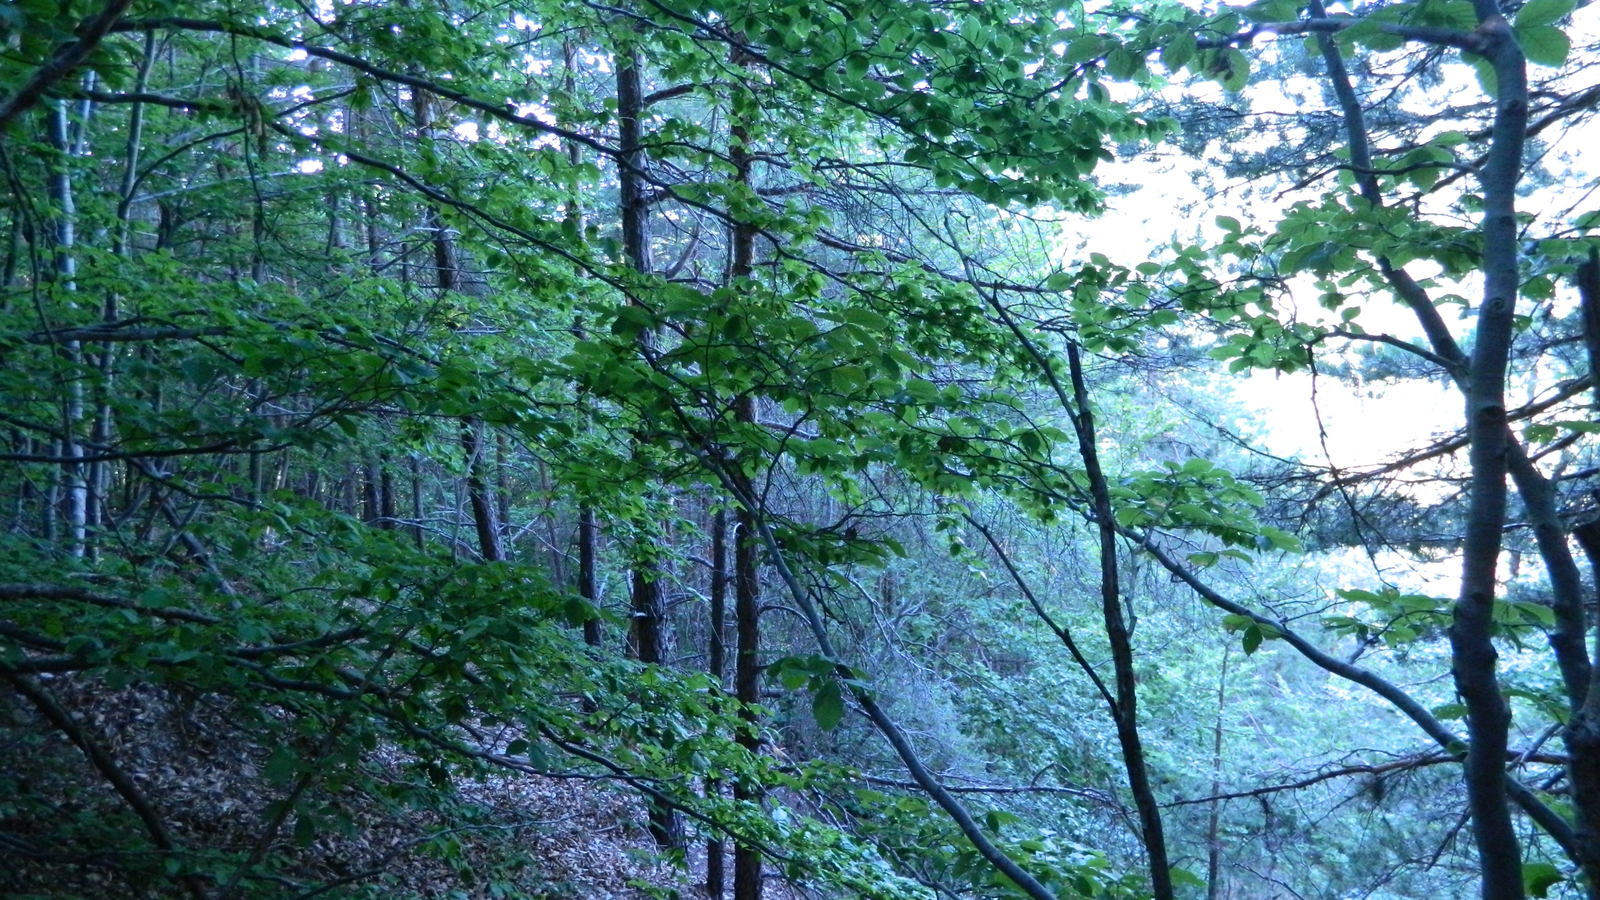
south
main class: Woodland
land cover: Pine dominated mixed woodland
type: hemiboreal forest and nemoral coniferous forest and mixed broadleaved-coniferous forest
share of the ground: > 75 %
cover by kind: coniferous forest trees 65 %, broadleaved forest trees 35 %
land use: Forestry
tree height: > 5 m
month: July
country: BG
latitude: 41.5979
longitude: 24.9127
